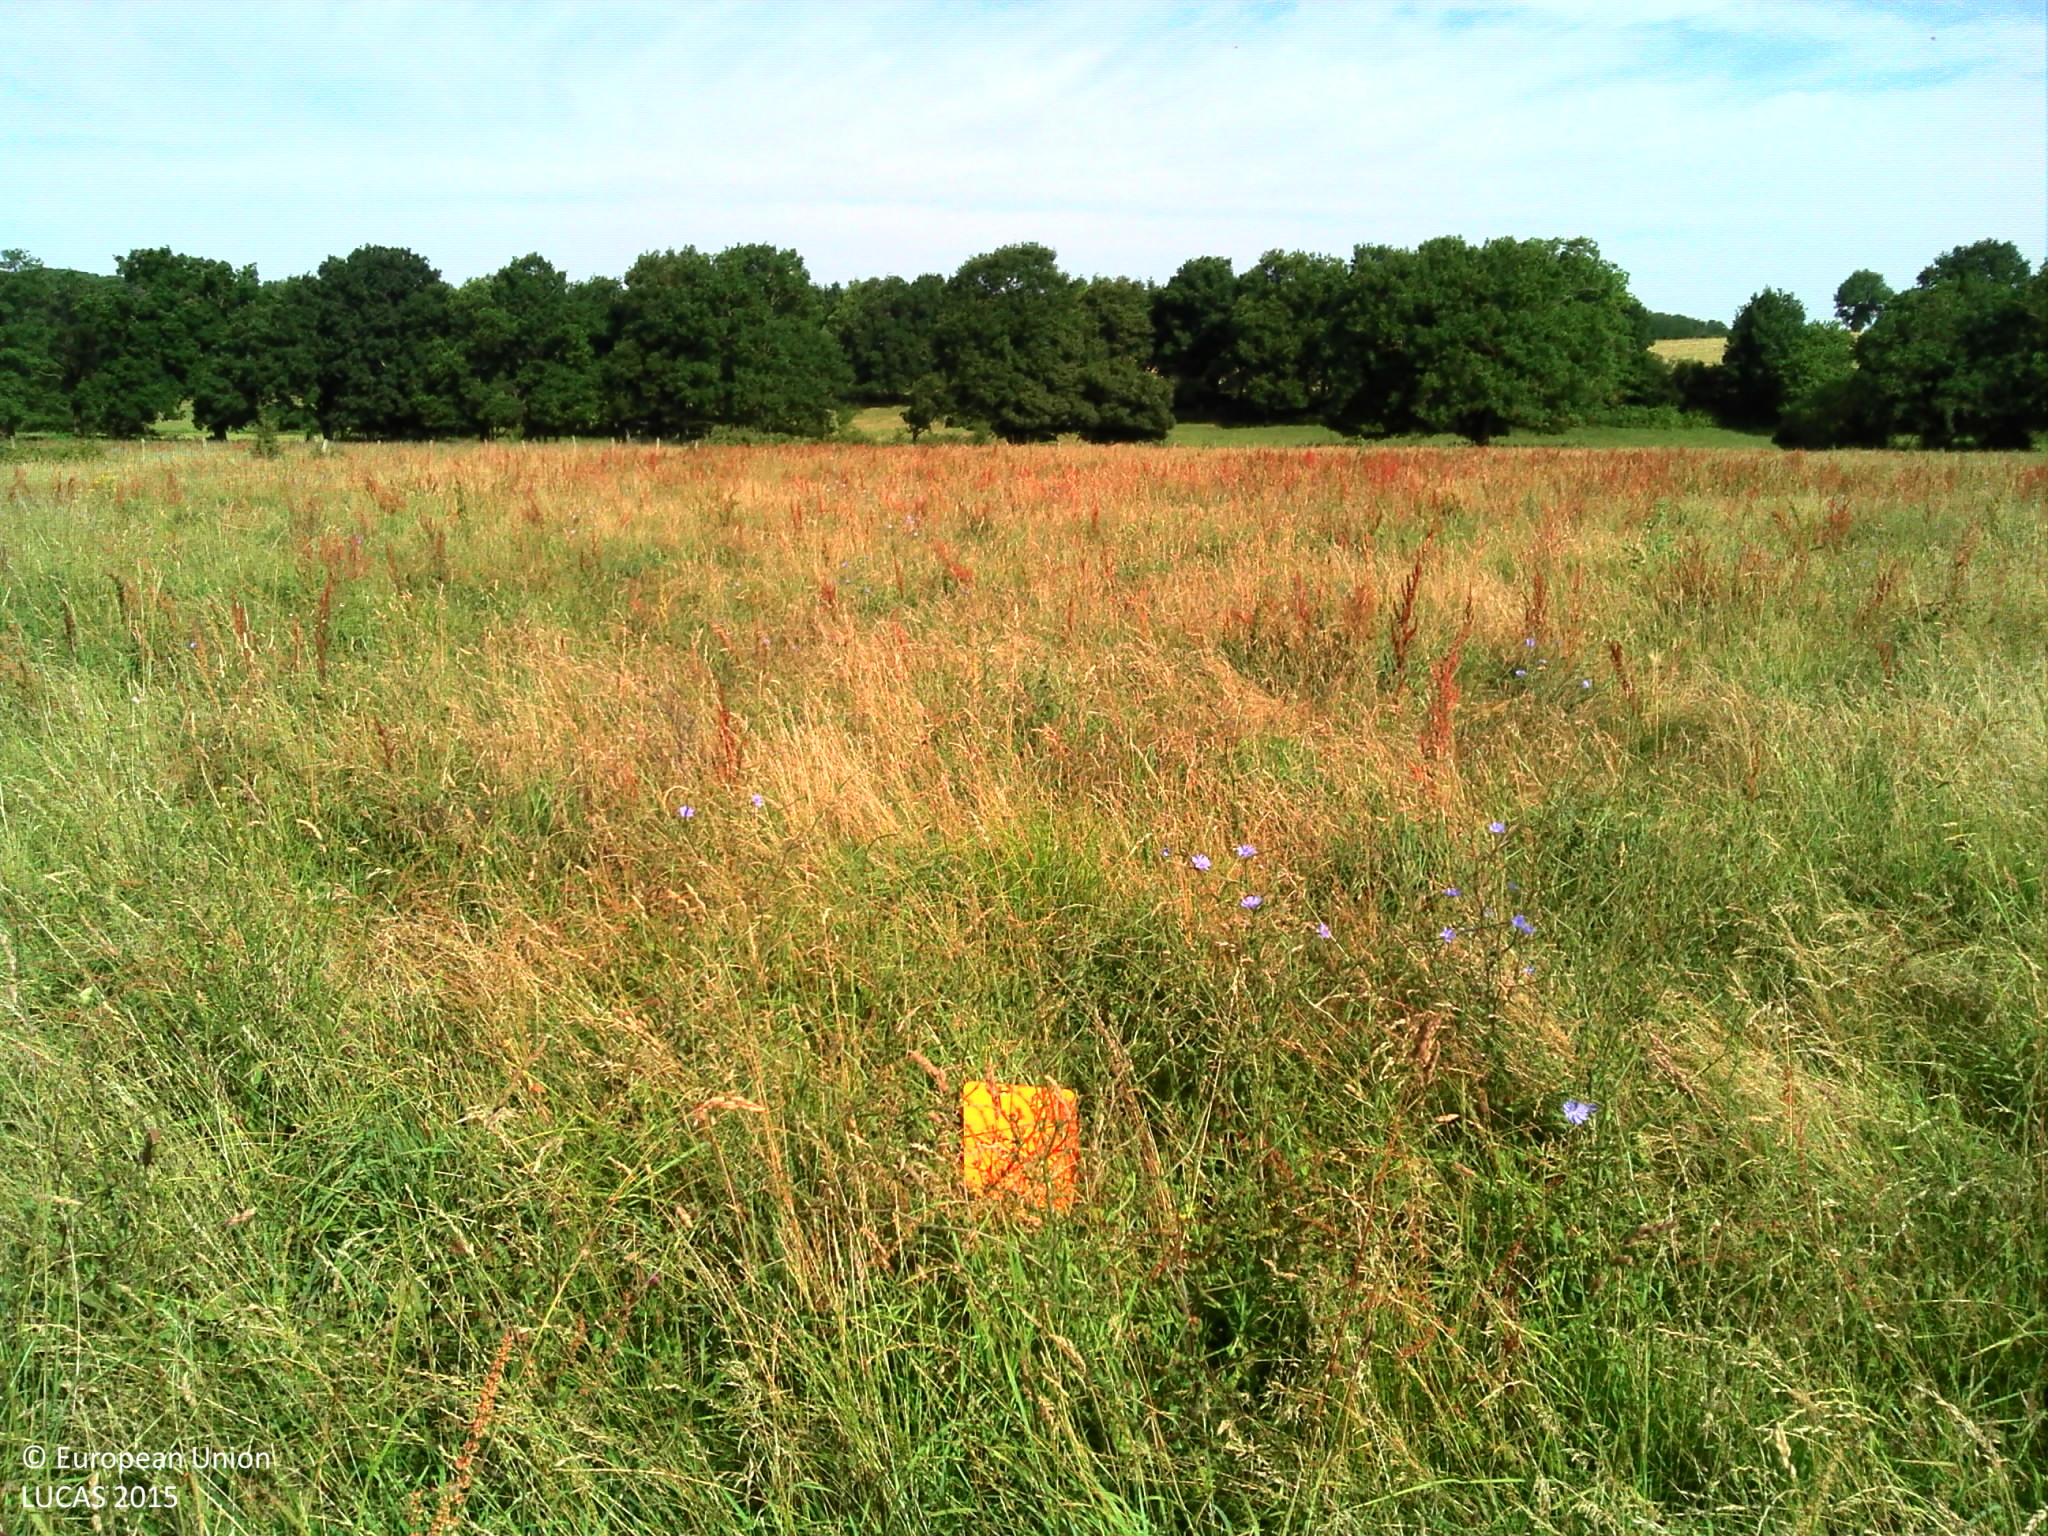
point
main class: Grassland
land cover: Grassland without tree/shrub cover
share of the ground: > 75 %
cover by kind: herbaceous plants 100 %
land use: Agriculture (excluding fallow land and kitchen gardens)
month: June
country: FR
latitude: 45.7404
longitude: 0.4360
